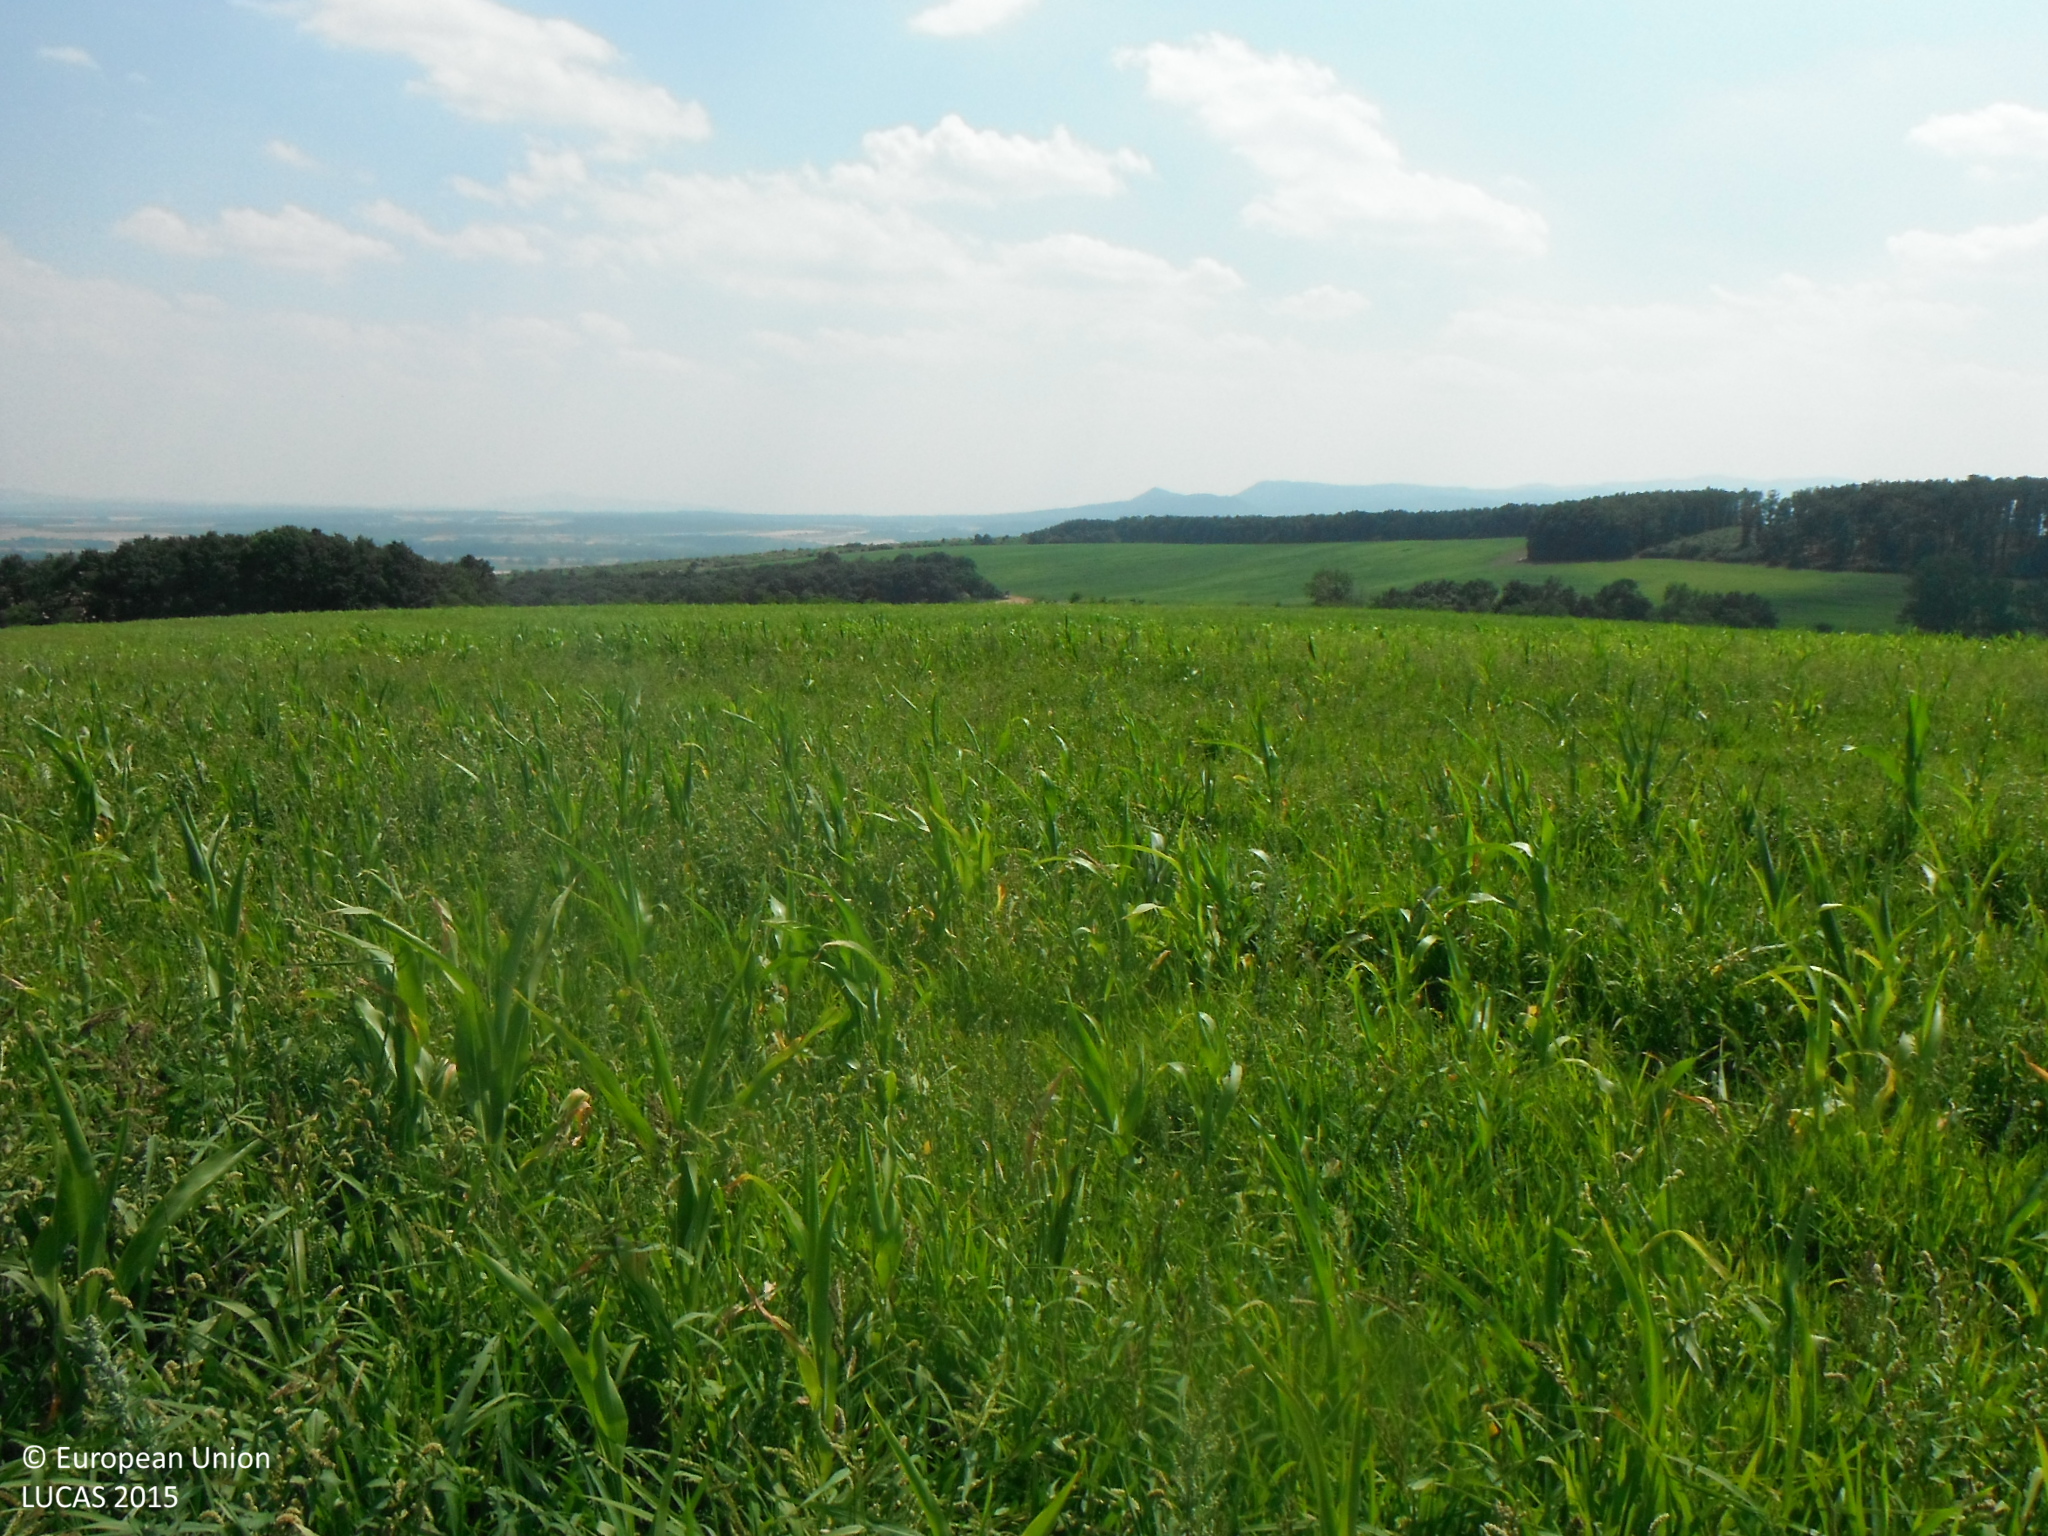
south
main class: Cropland
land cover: Maize
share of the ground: 25 - 50 %
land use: Agriculture (excluding fallow land and kitchen gardens)
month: July
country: SK
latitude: 48.1035
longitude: 19.0579
